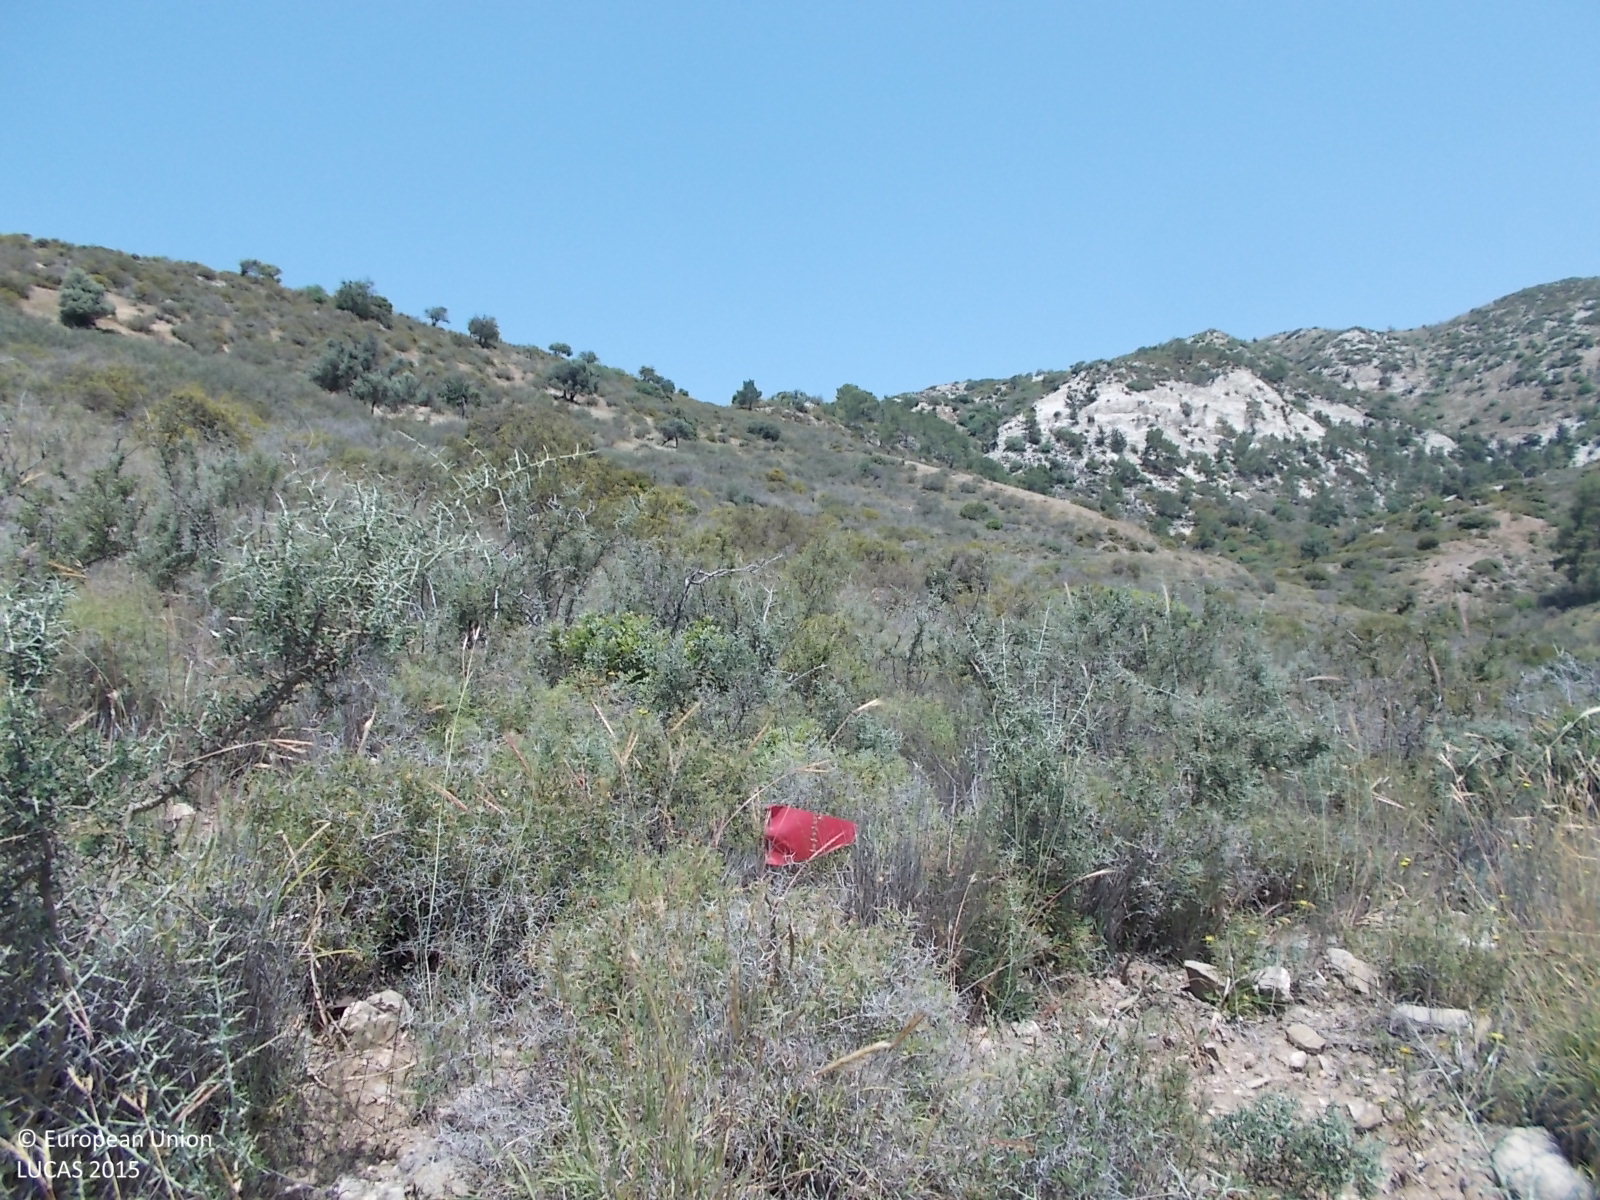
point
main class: Shrubland
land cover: Shrubland without tree cover
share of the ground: > 75 %
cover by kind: shrubs 90 %, unconsolidated bare surface 10 %
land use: Semi-natural and natural areas not in use
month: May
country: CY
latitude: 34.8908
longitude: 32.3930
